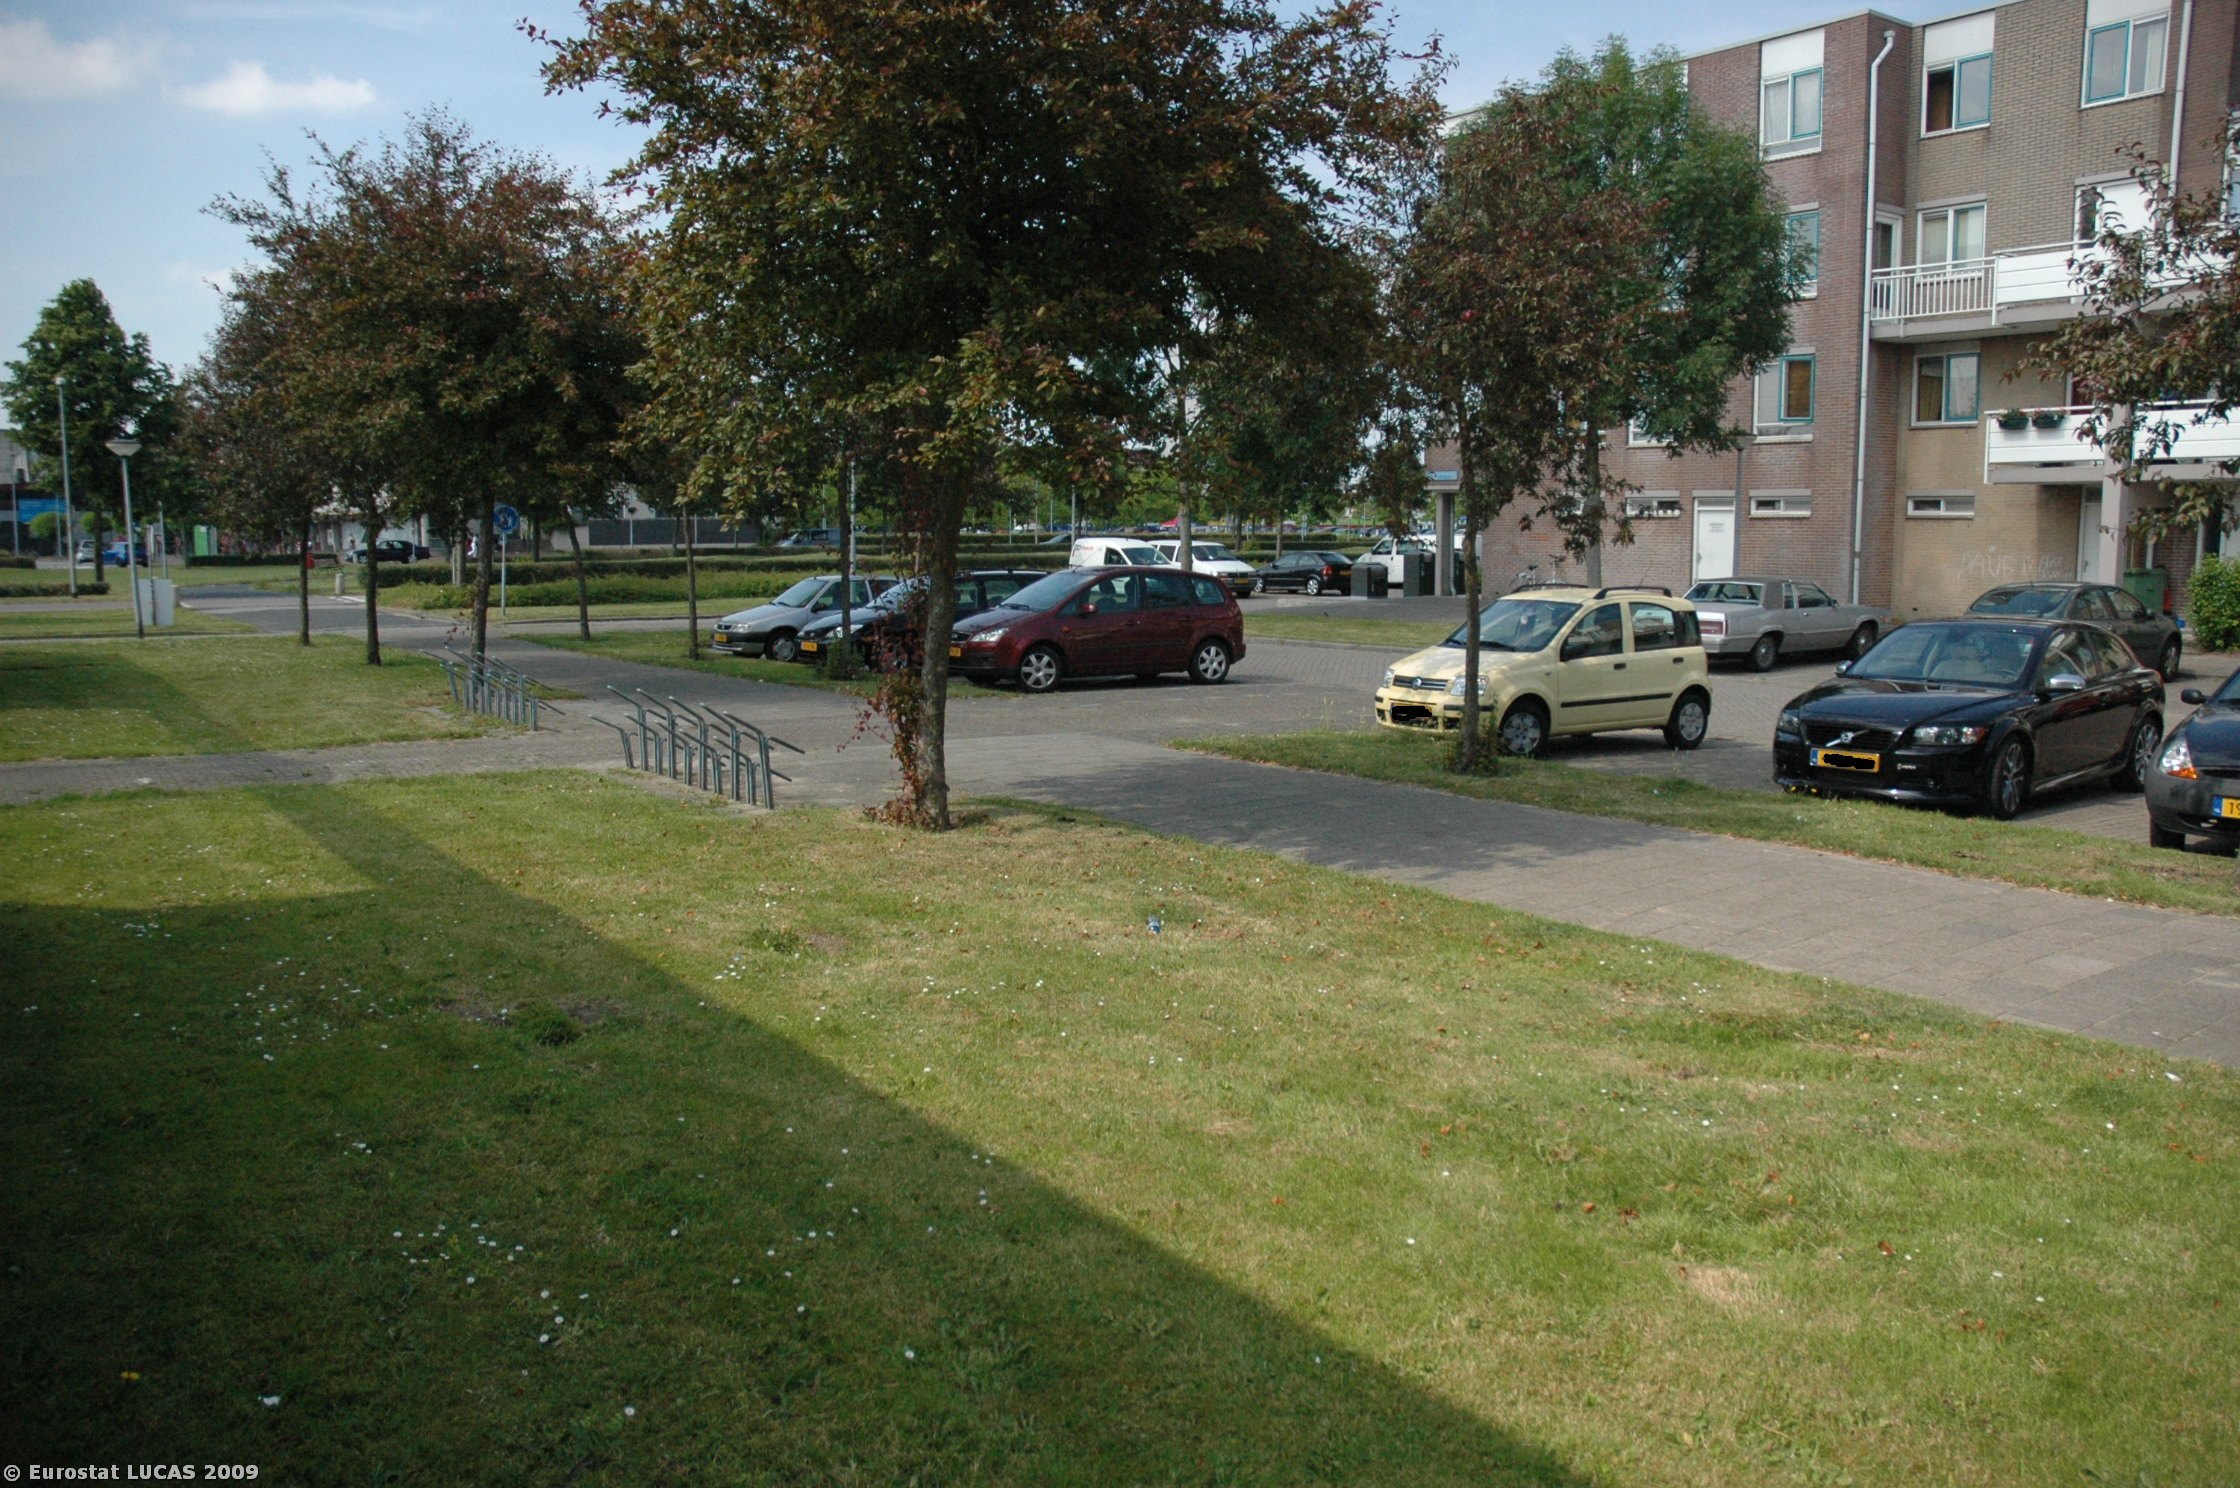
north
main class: Grassland
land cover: Grassland without tree/shrub cover
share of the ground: > 75 %
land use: Residential
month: June
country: NL
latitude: 52.3918
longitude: 5.2810
